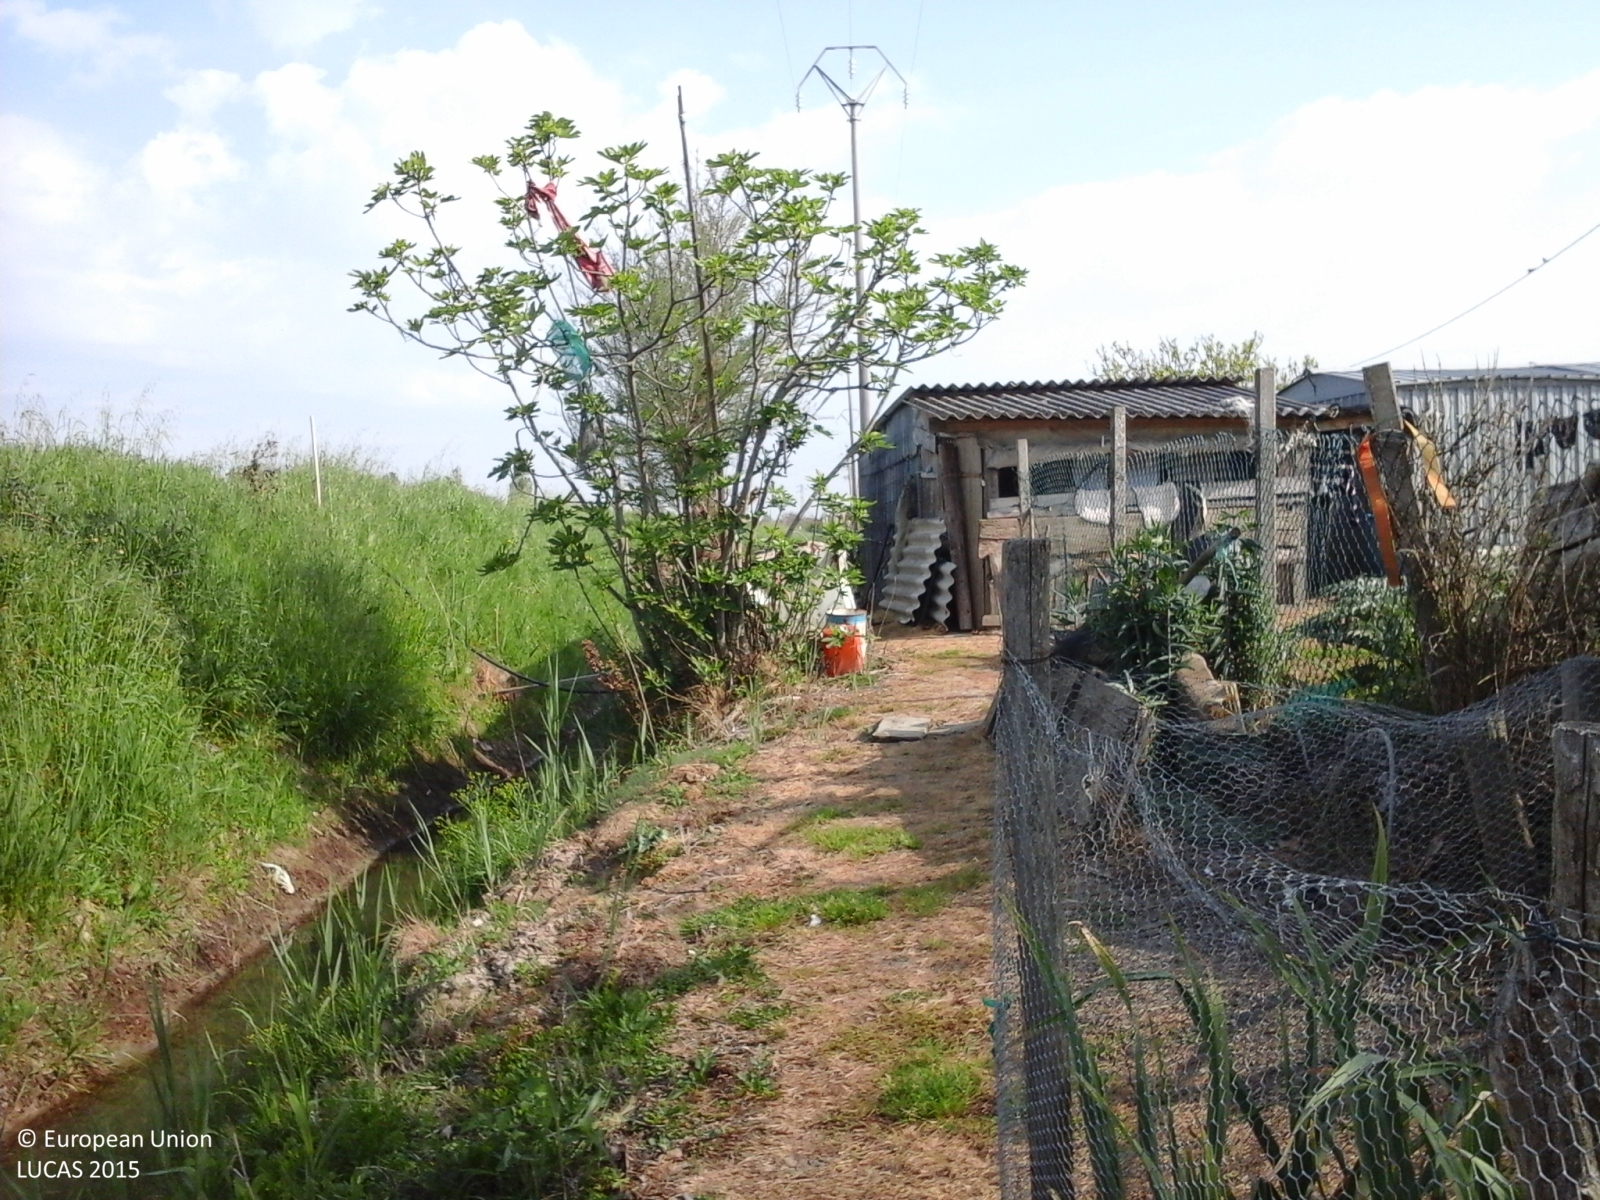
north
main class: Cropland
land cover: Other fresh vegetables
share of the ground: < 10 %
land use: Kitchen garden
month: April
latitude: 44.8625
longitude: 12.4633
